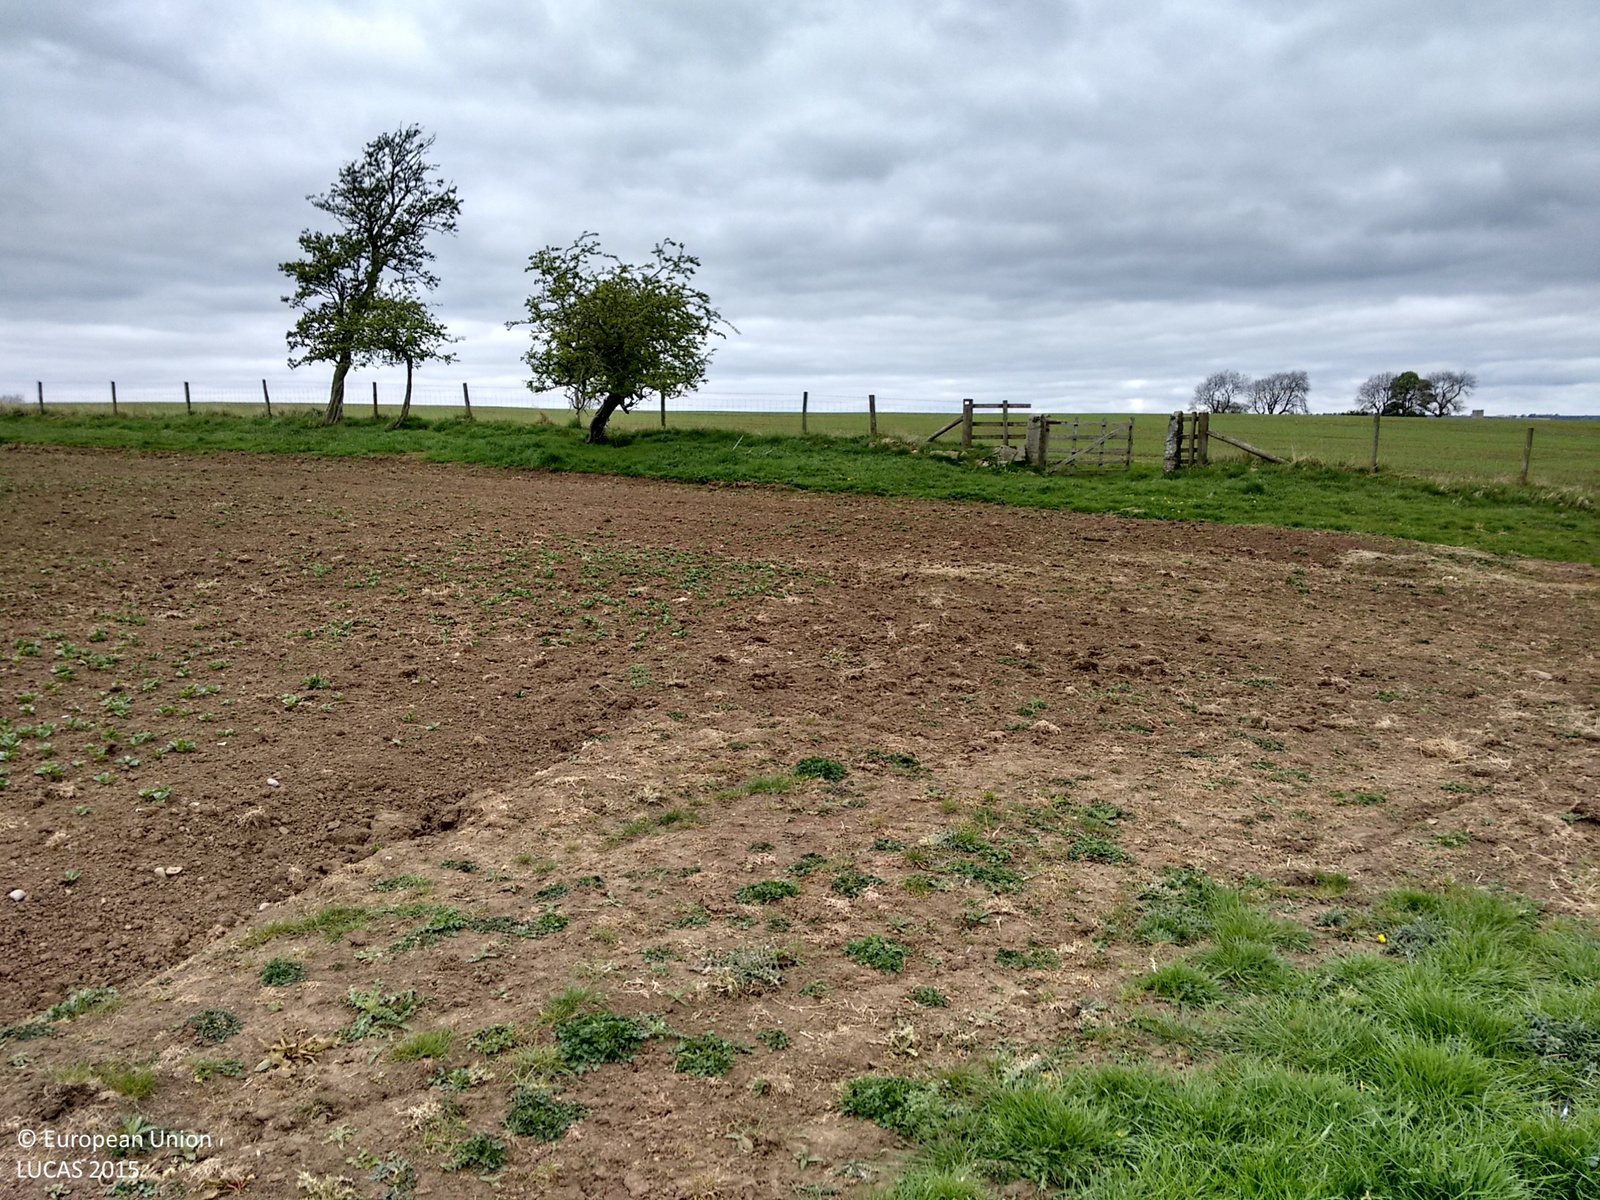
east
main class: Grassland
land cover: Grassland without tree/shrub cover
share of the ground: > 75 %
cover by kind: herbaceous plants 100 %
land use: Agriculture (excluding fallow land and kitchen gardens)
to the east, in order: Grassland without tree/shrub cover; Fences; Rivers and streams; Fences; Grassland without tree/shrub cover; Abandoned hedges; Fences; Arable land (only in case pi)
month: May
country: GB
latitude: 55.0228
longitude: -1.9891
